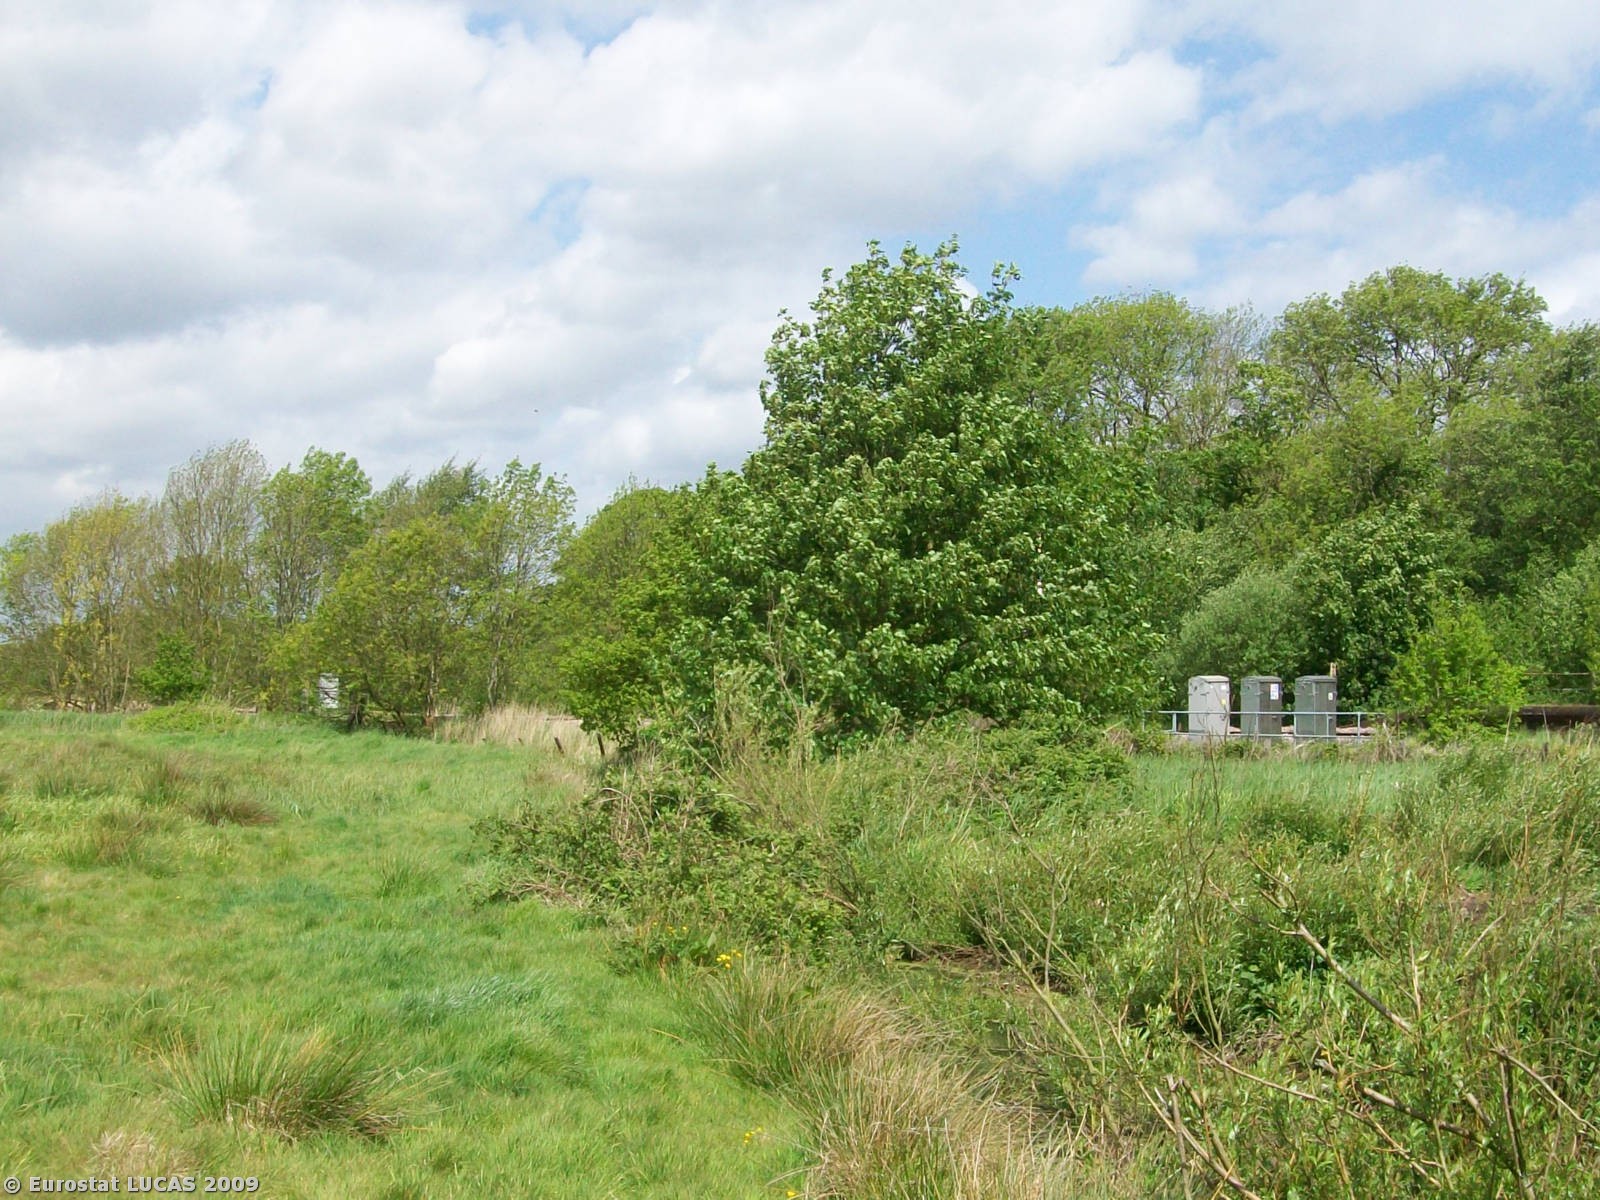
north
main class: Grassland
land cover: Grassland without tree/shrub cover
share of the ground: > 75 %
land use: Unused
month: May
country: GB
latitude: 52.5645
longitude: 1.5578
